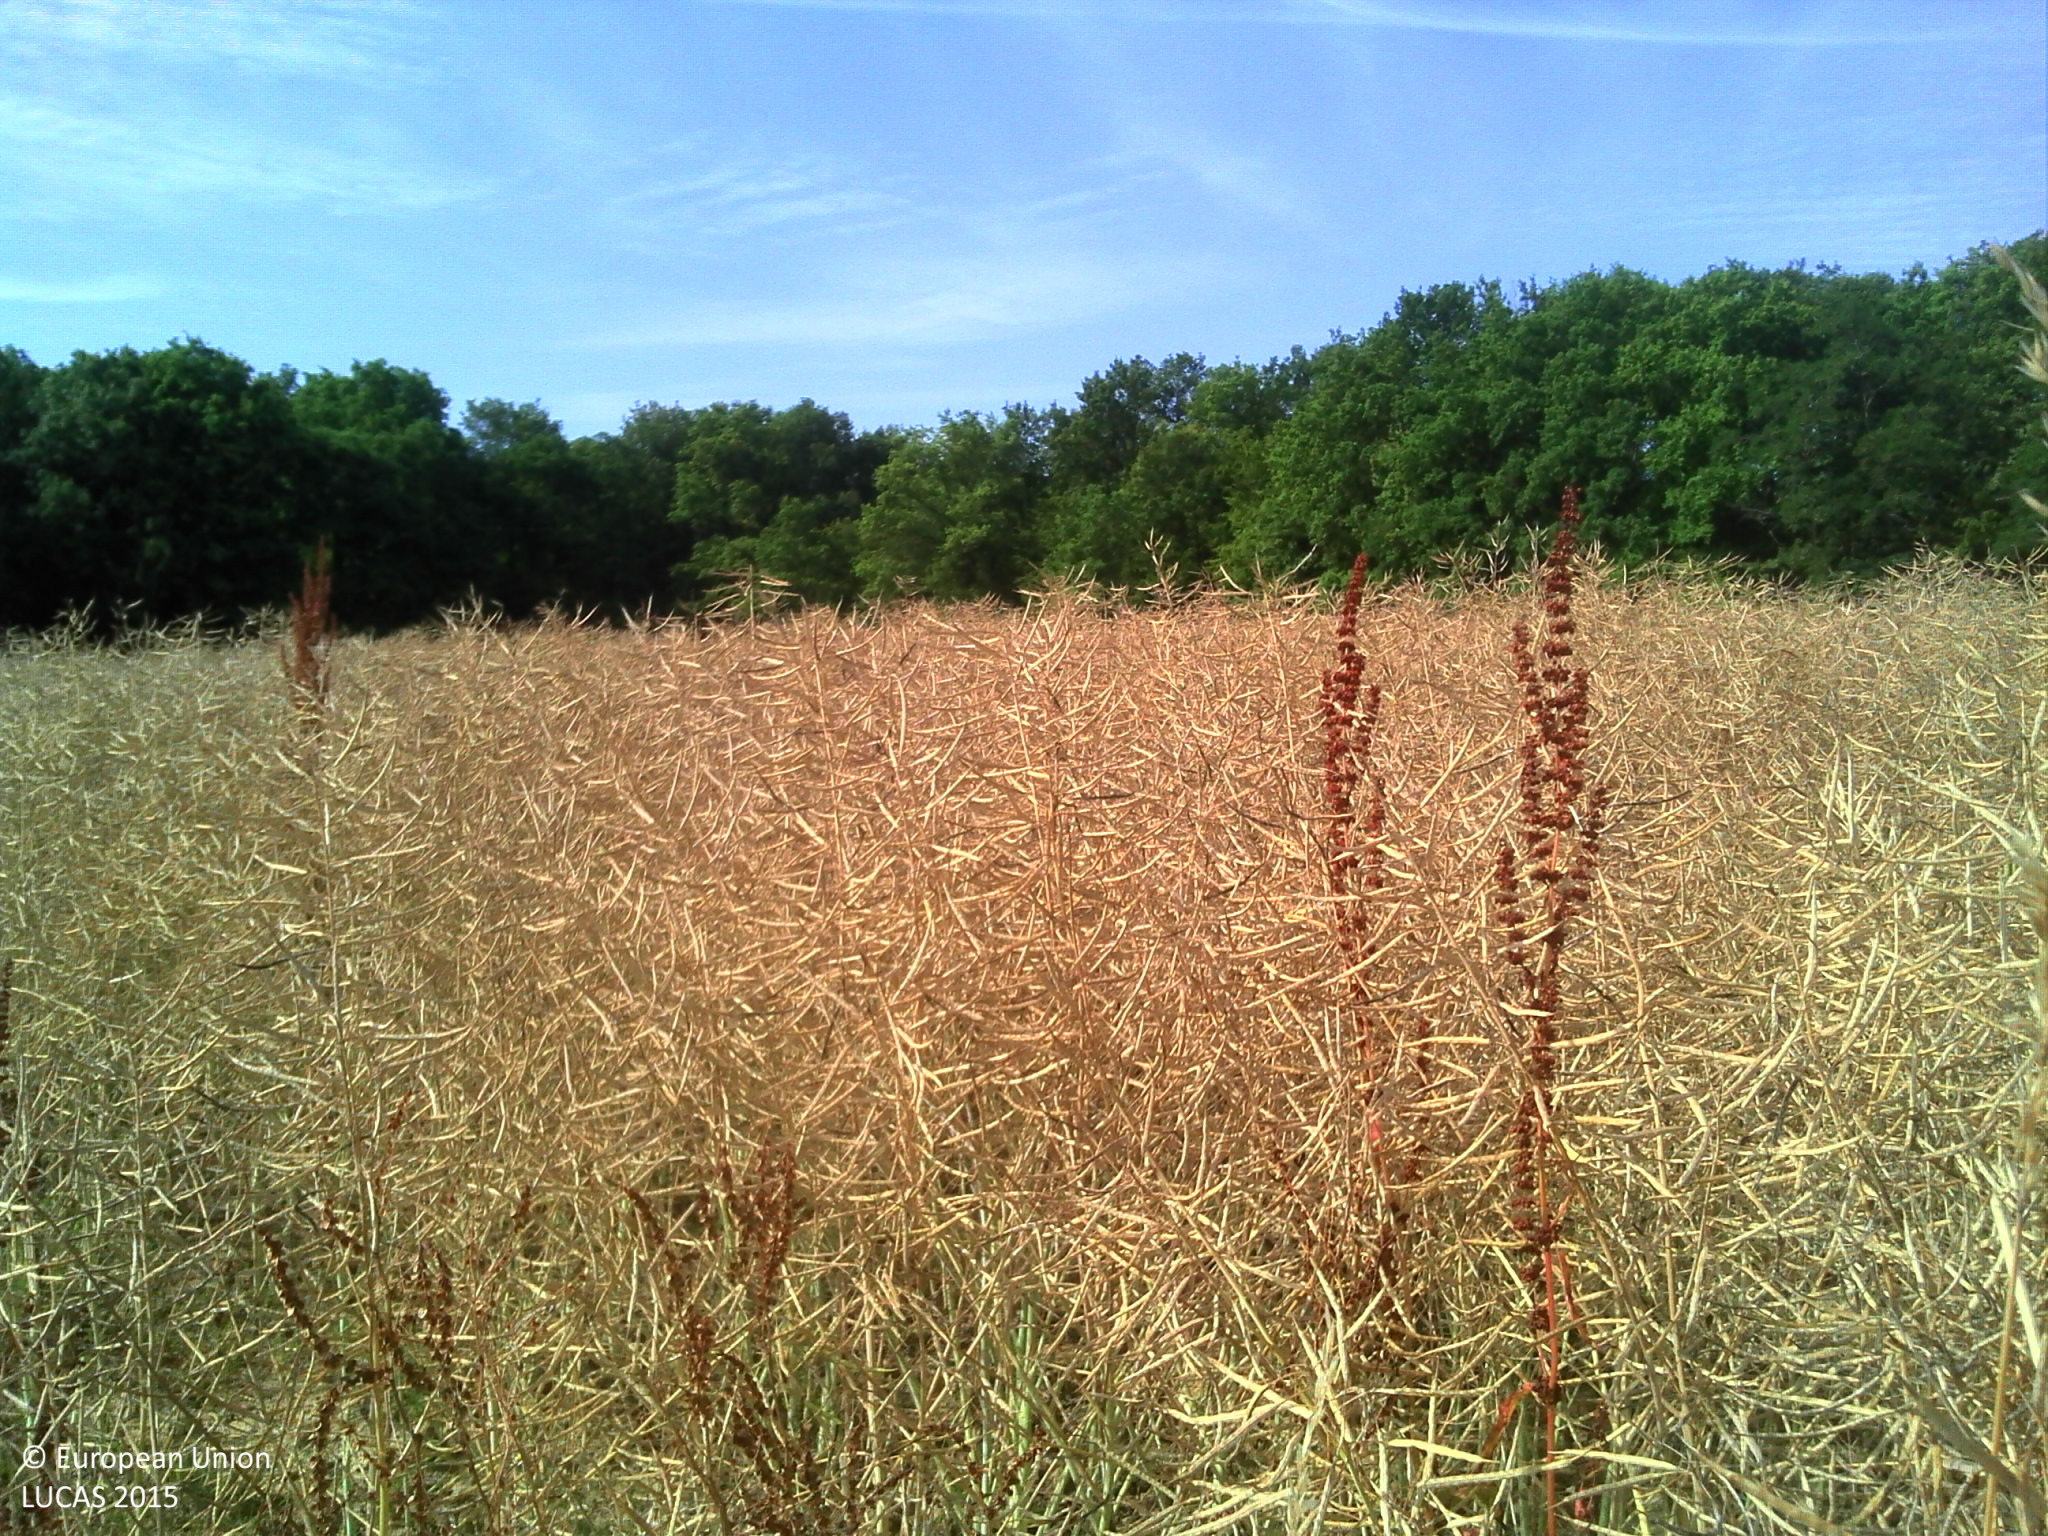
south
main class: Cropland
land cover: Rape and turnip rape
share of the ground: > 75 %
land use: Agriculture (excluding fallow land and kitchen gardens)
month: June
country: FR
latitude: 46.7136
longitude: 4.8342
